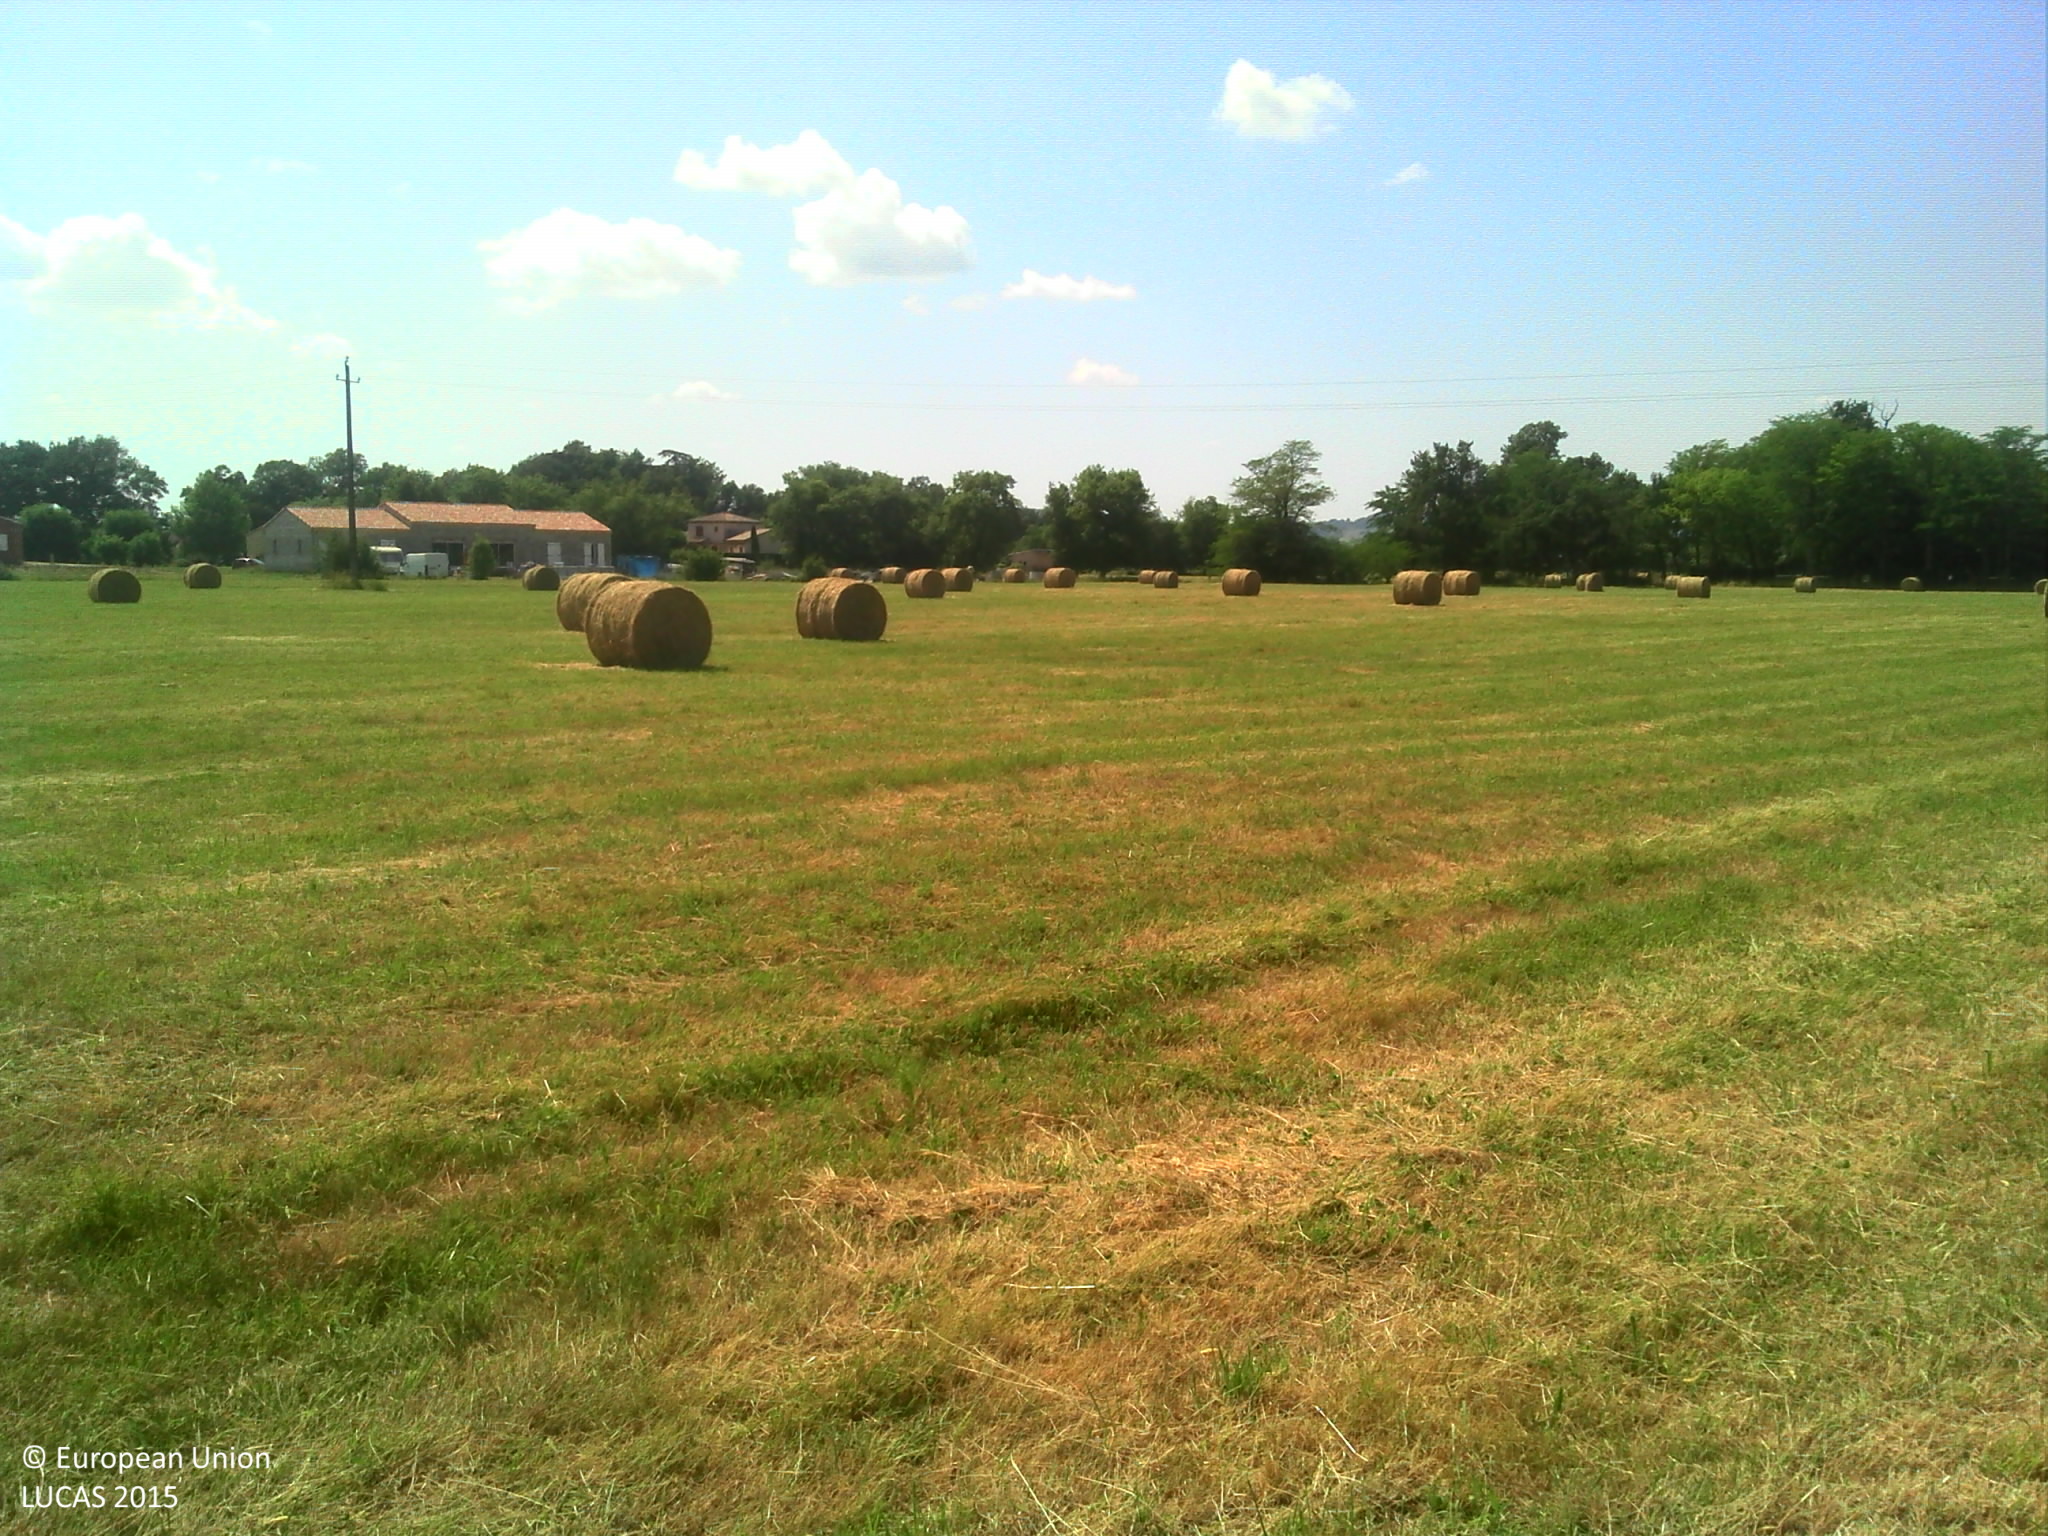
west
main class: Grassland
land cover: Grassland without tree/shrub cover
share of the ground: > 75 %
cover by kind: herbaceous plants 100 %
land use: Agriculture (excluding fallow land and kitchen gardens)
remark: Harvested field
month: June
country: FR
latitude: 43.5632
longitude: 2.1441
